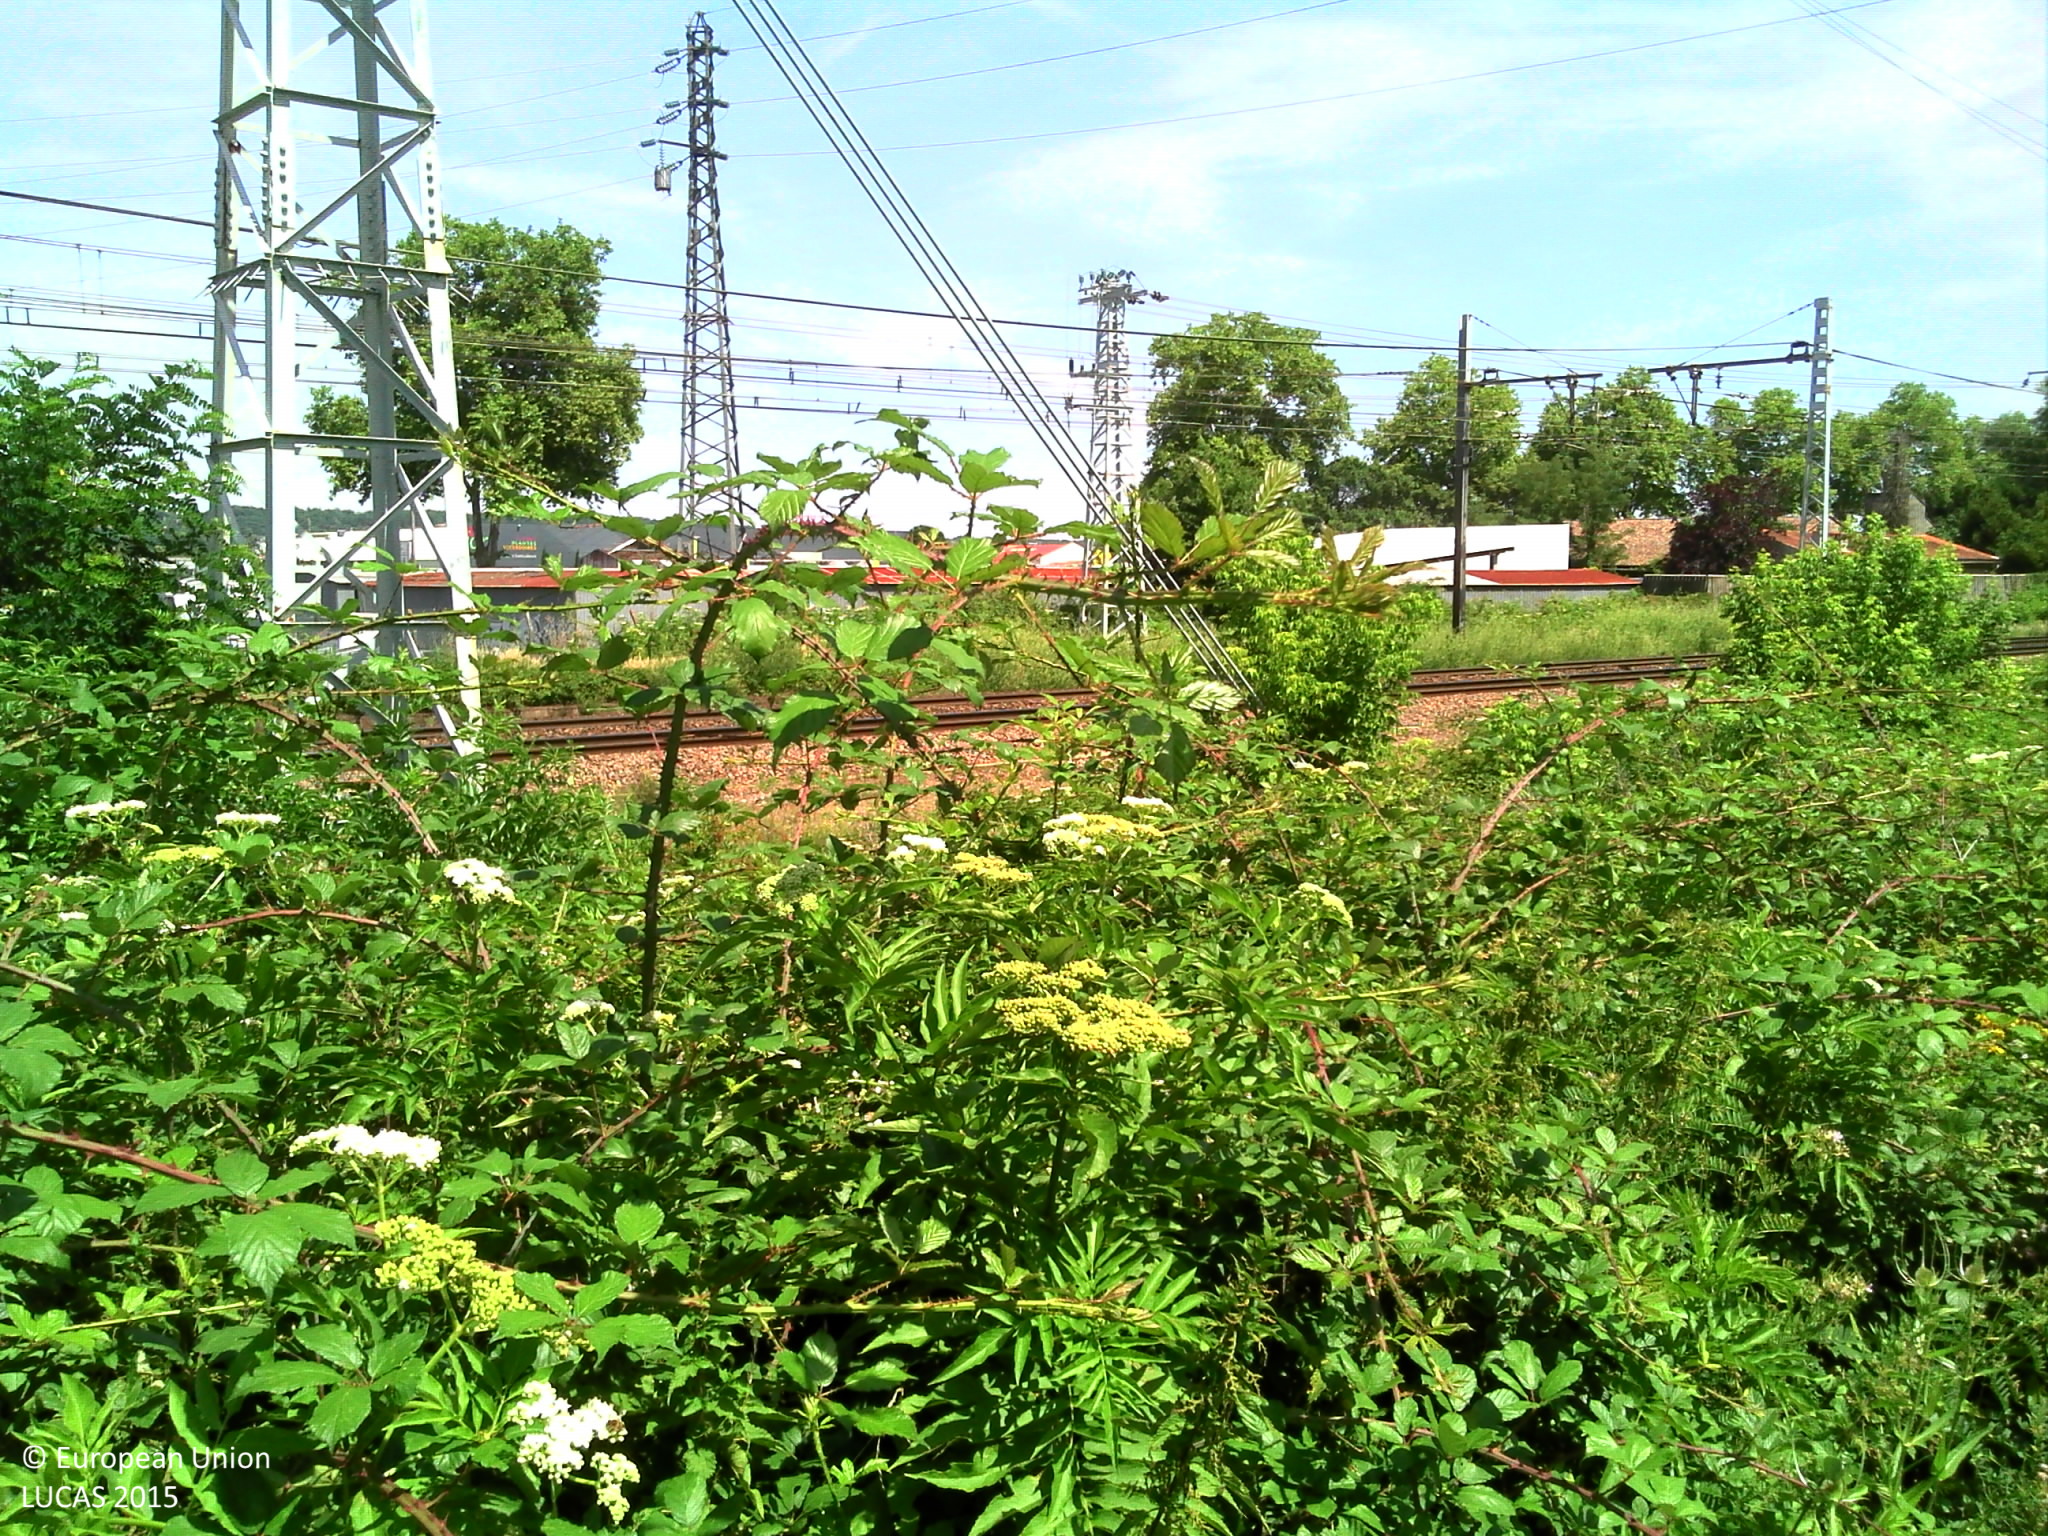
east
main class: Shrubland
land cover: Shrubland with sparse tree cover
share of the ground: > 75 %
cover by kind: shrubs 60 %, herbaceous plants 20 %, consolidated bare surface 15 %, broadleaved forest trees 5 %
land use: Semi-natural and natural areas not in use
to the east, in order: Tracks; Shrubland with sparse tree cover; Electric lines; Railways; Electric lines; Ditches and canals; Artificial constructions in urban areas; Grassland with sparse tree/shrub cover; Artificial constructions in urban areas
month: June
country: FR
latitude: 43.7368
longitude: 1.3723
